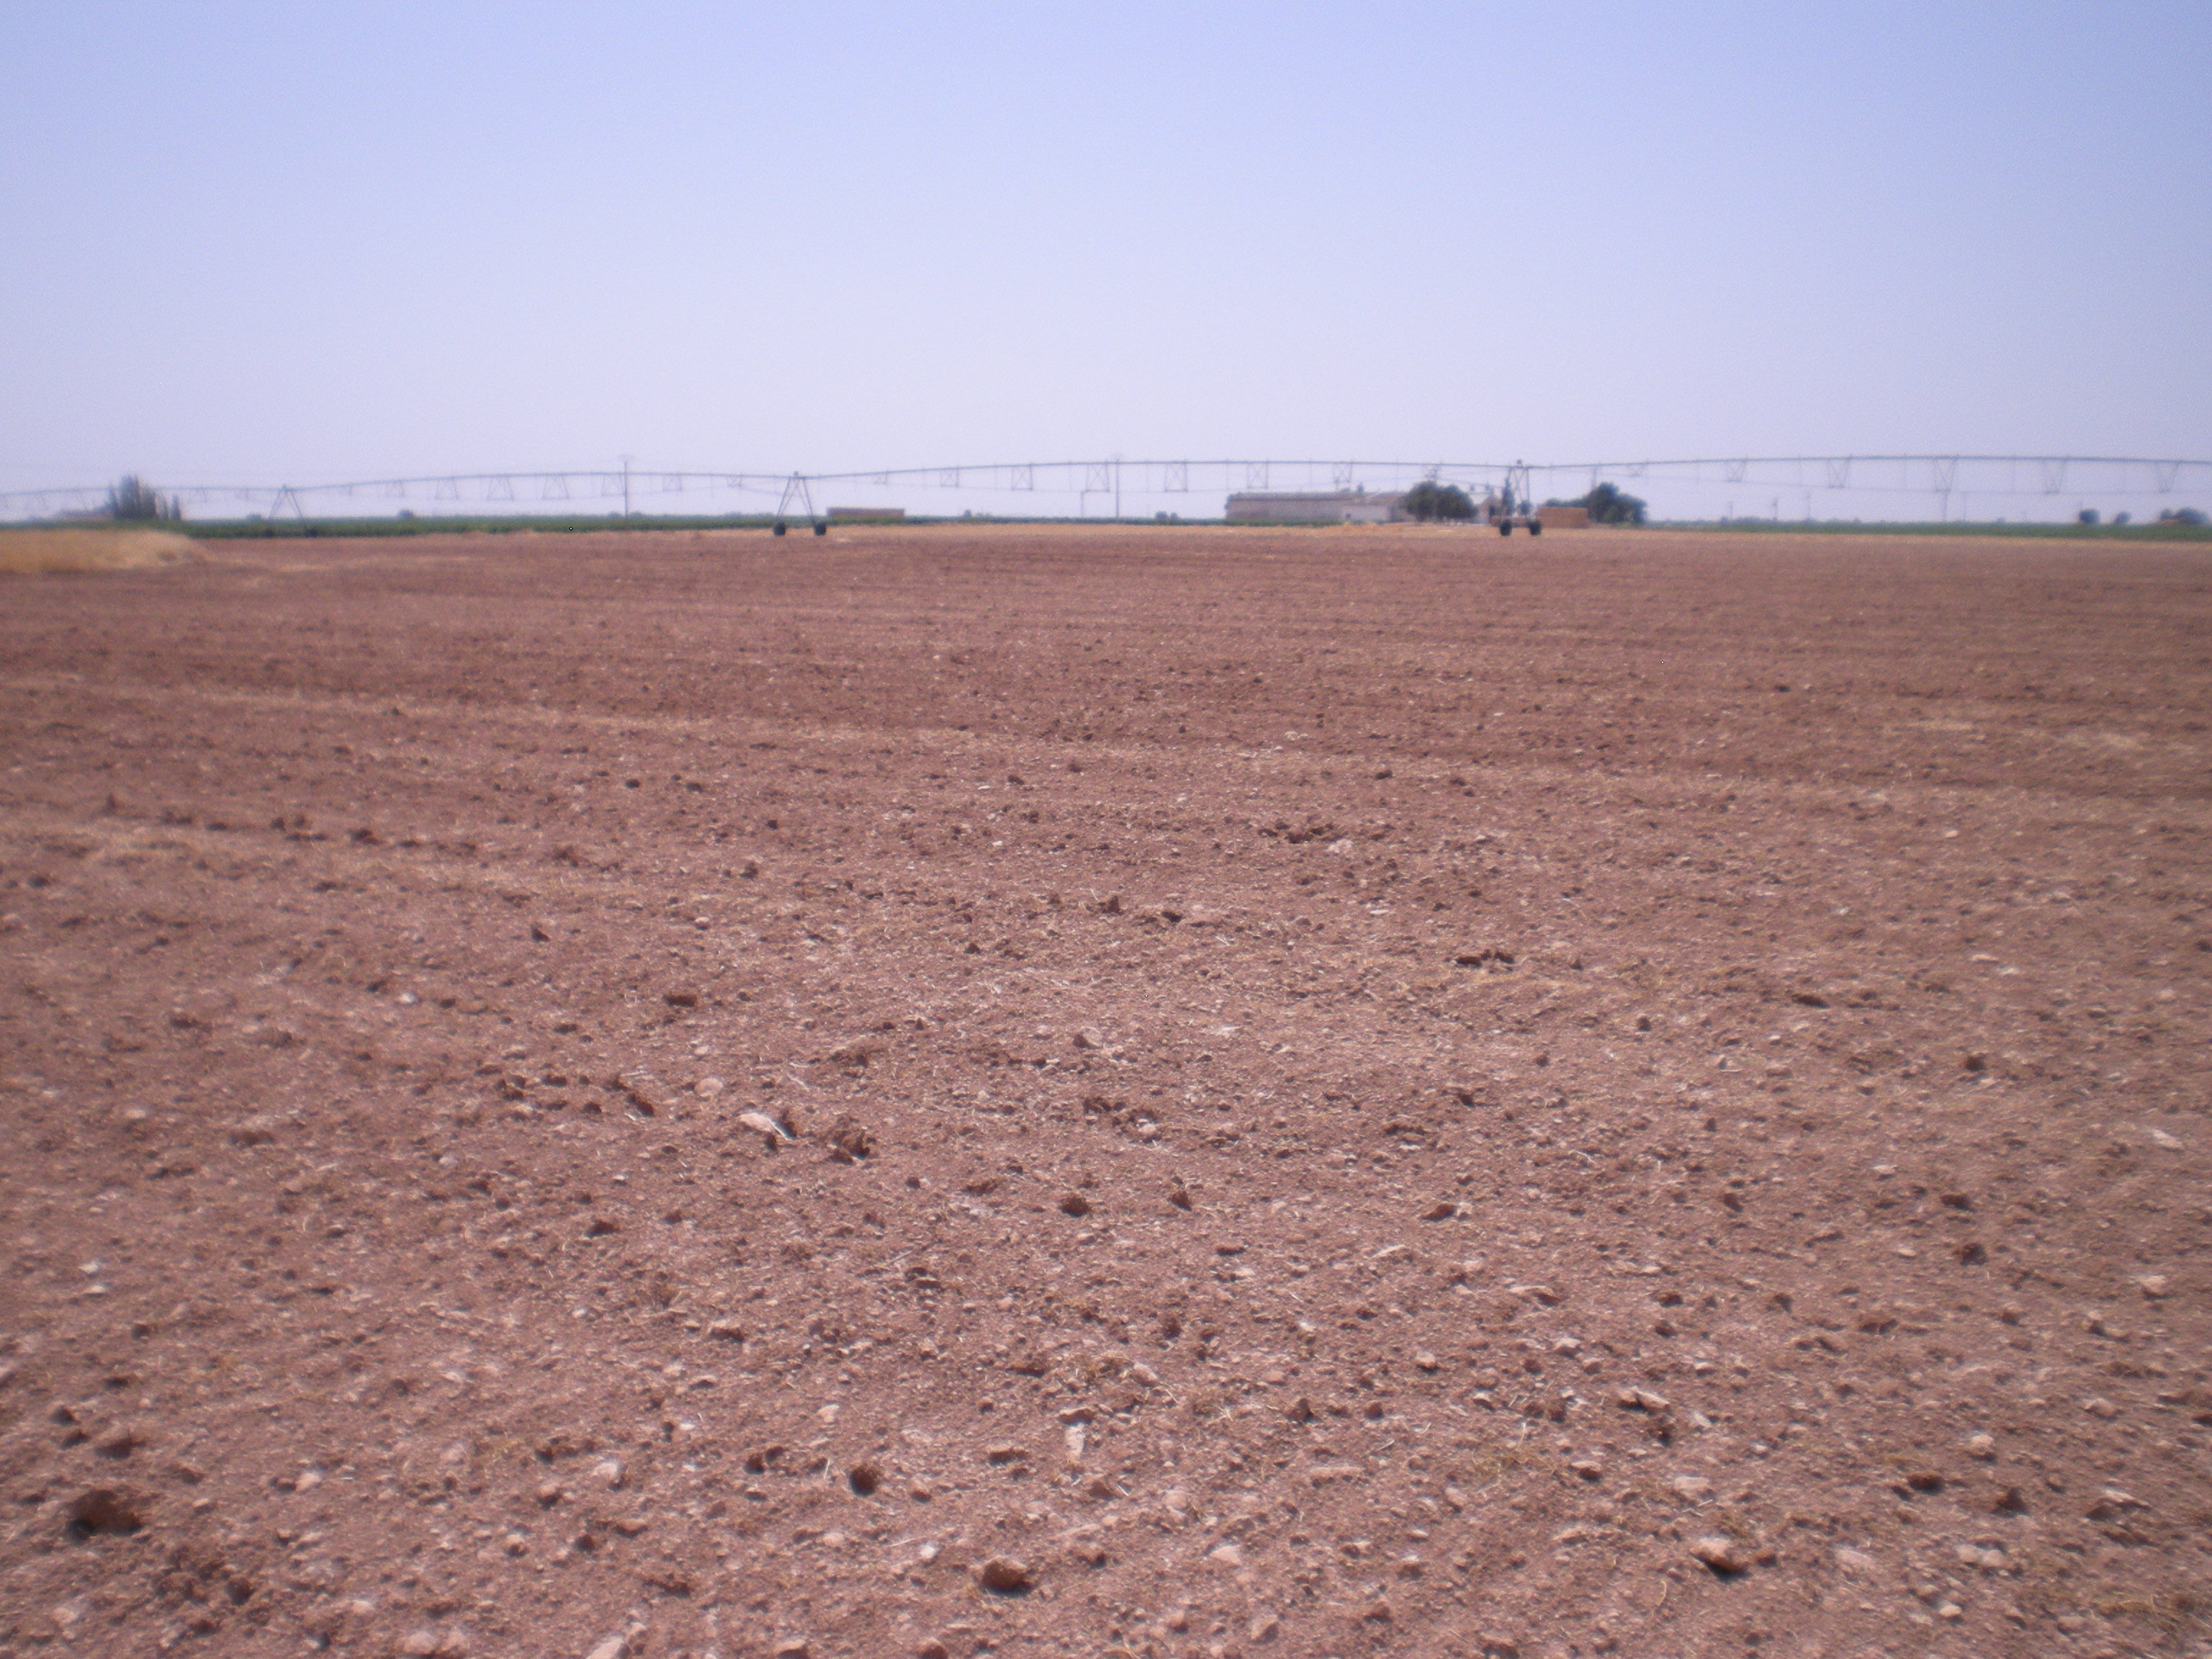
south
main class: Cropland
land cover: Dry pulses
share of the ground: < 10 %
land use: Agriculture (excluding fallow land and kitchen gardens)
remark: Harvested field
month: July
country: ES
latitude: 39.2350
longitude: -3.2580
